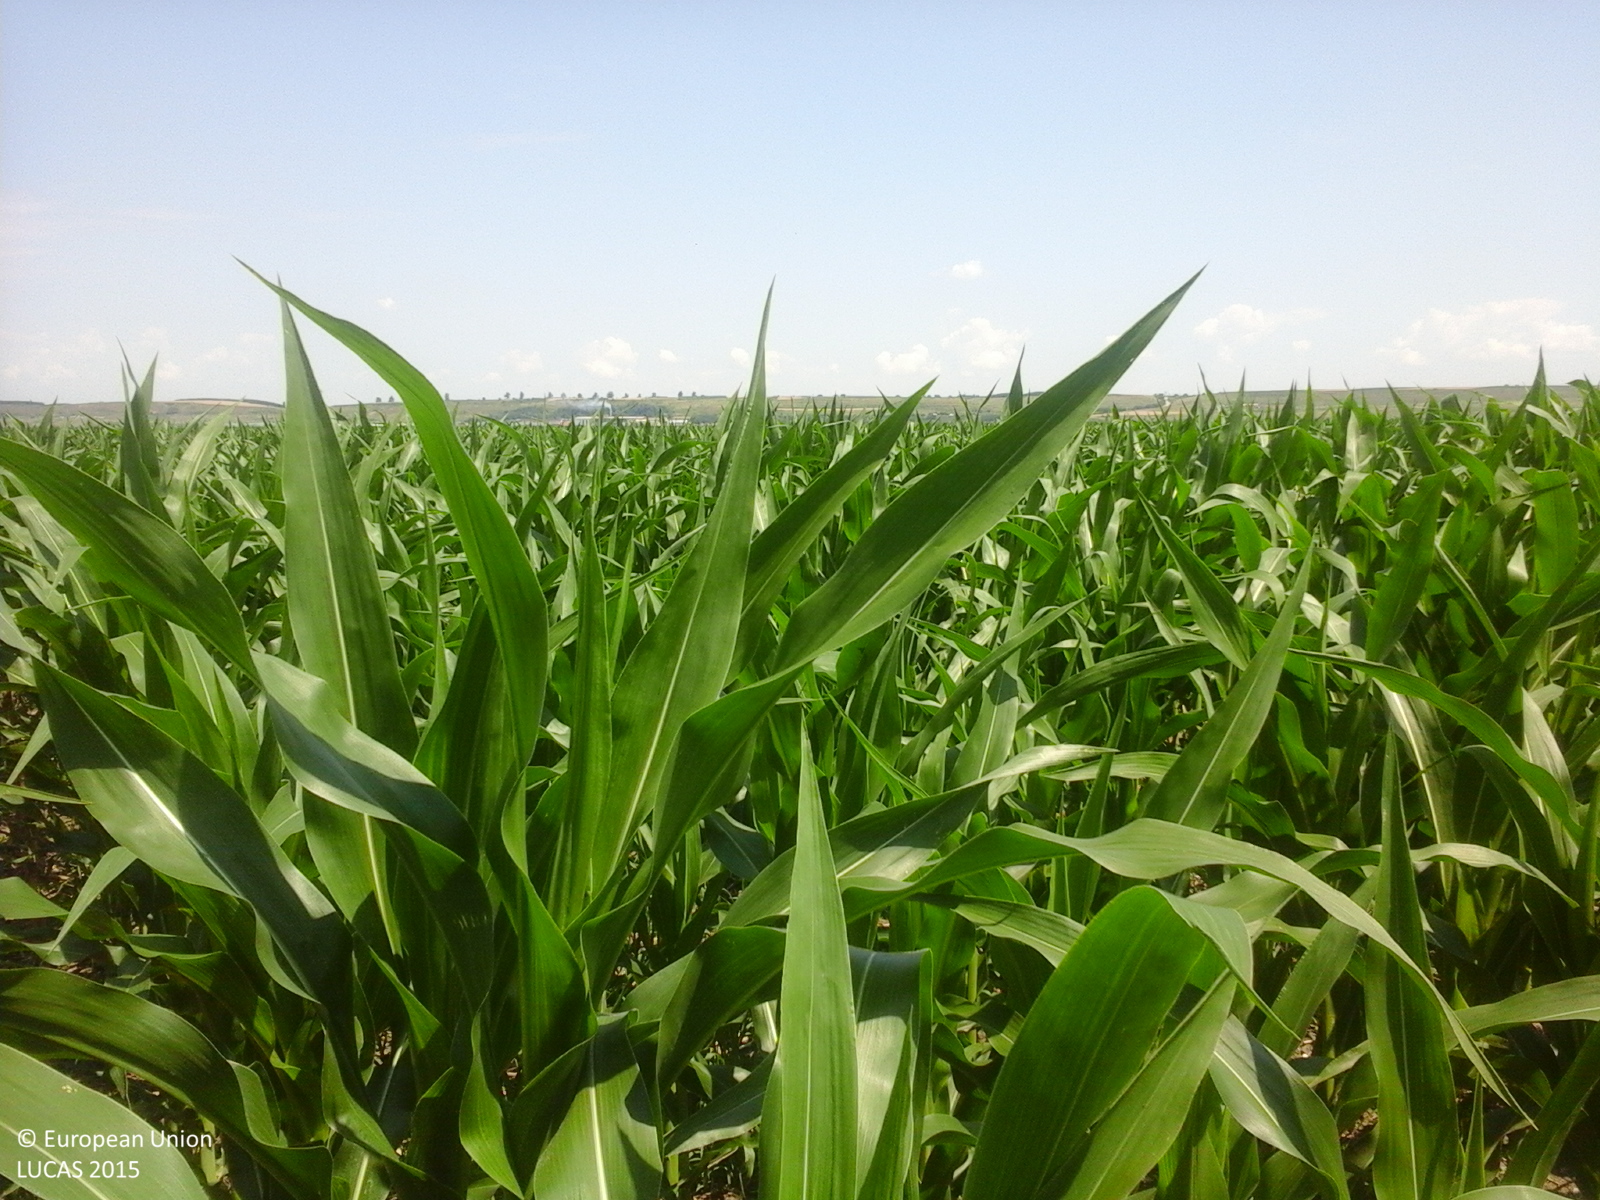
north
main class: Cropland
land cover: Maize
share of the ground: > 75 %
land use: Agriculture (excluding fallow land and kitchen gardens)
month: June
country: RO
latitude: 44.0951
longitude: 26.4352
